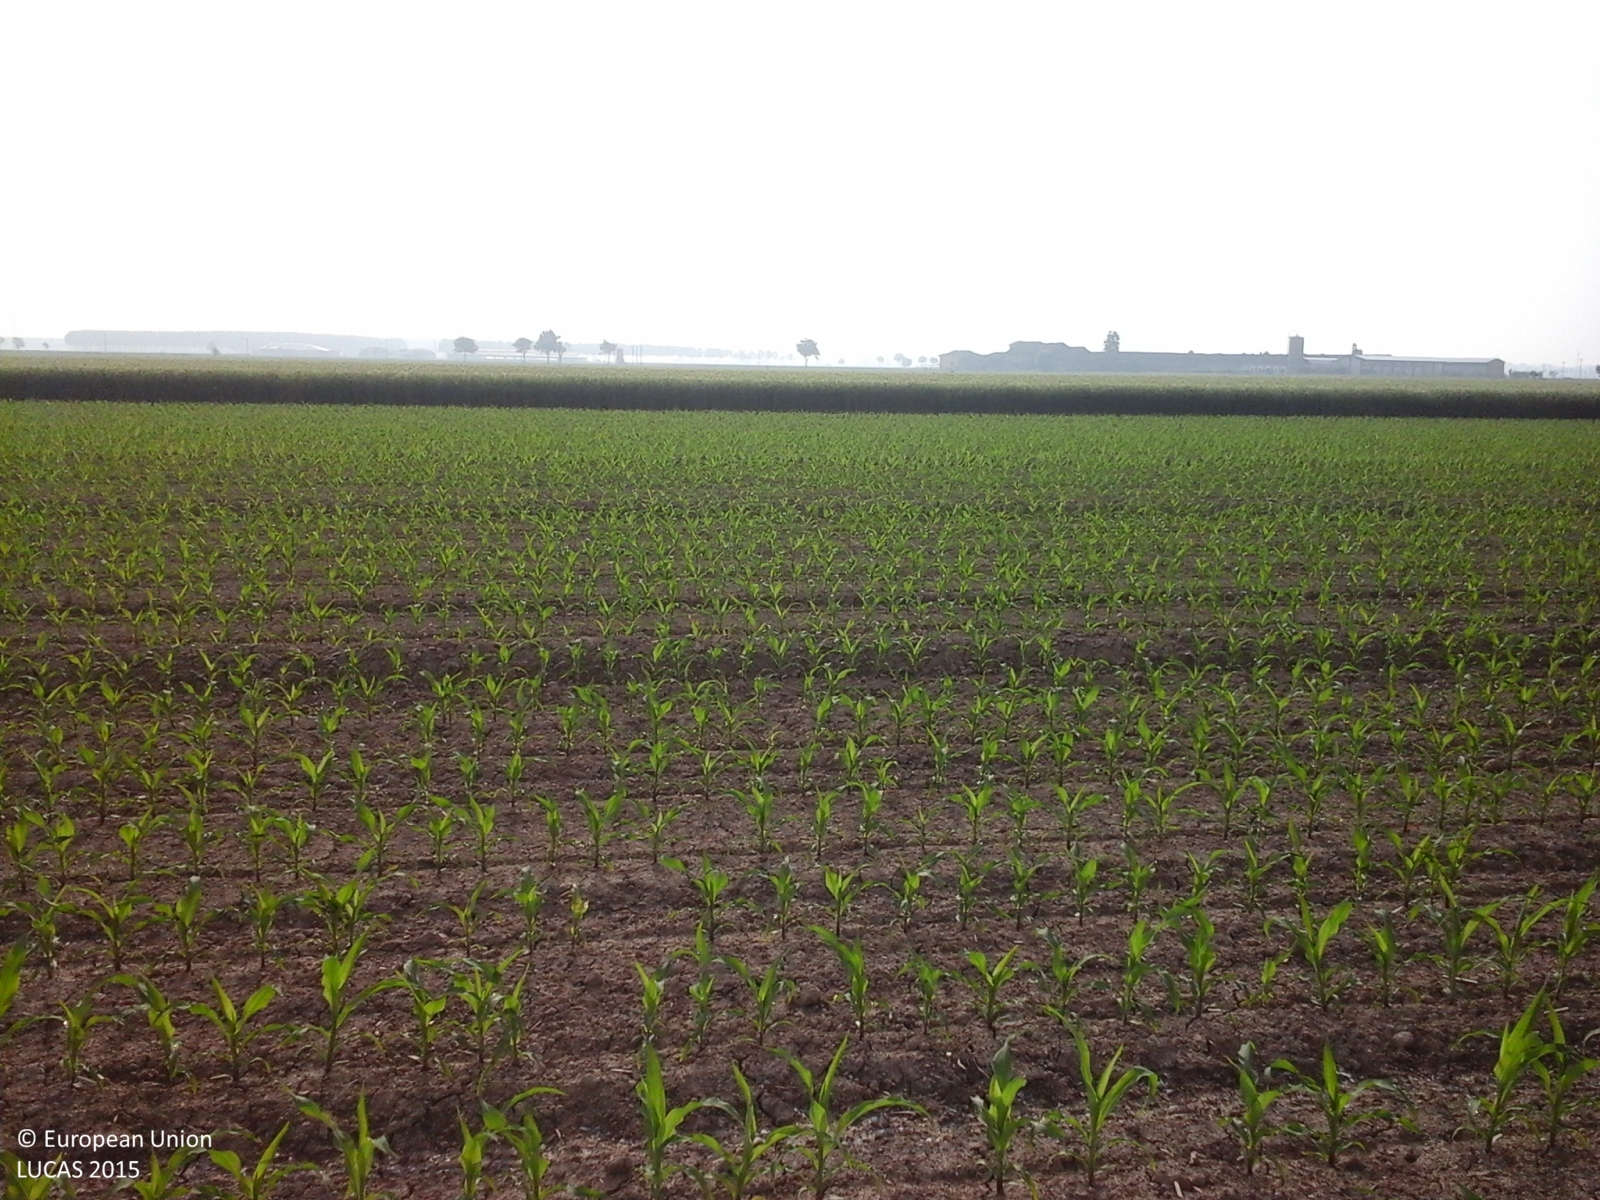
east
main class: Cropland
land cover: Maize
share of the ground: 10 - 25 %
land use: Agriculture (excluding fallow land and kitchen gardens)
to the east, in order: Maize; Triticale
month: May
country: IT
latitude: 44.8114
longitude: 7.6652
